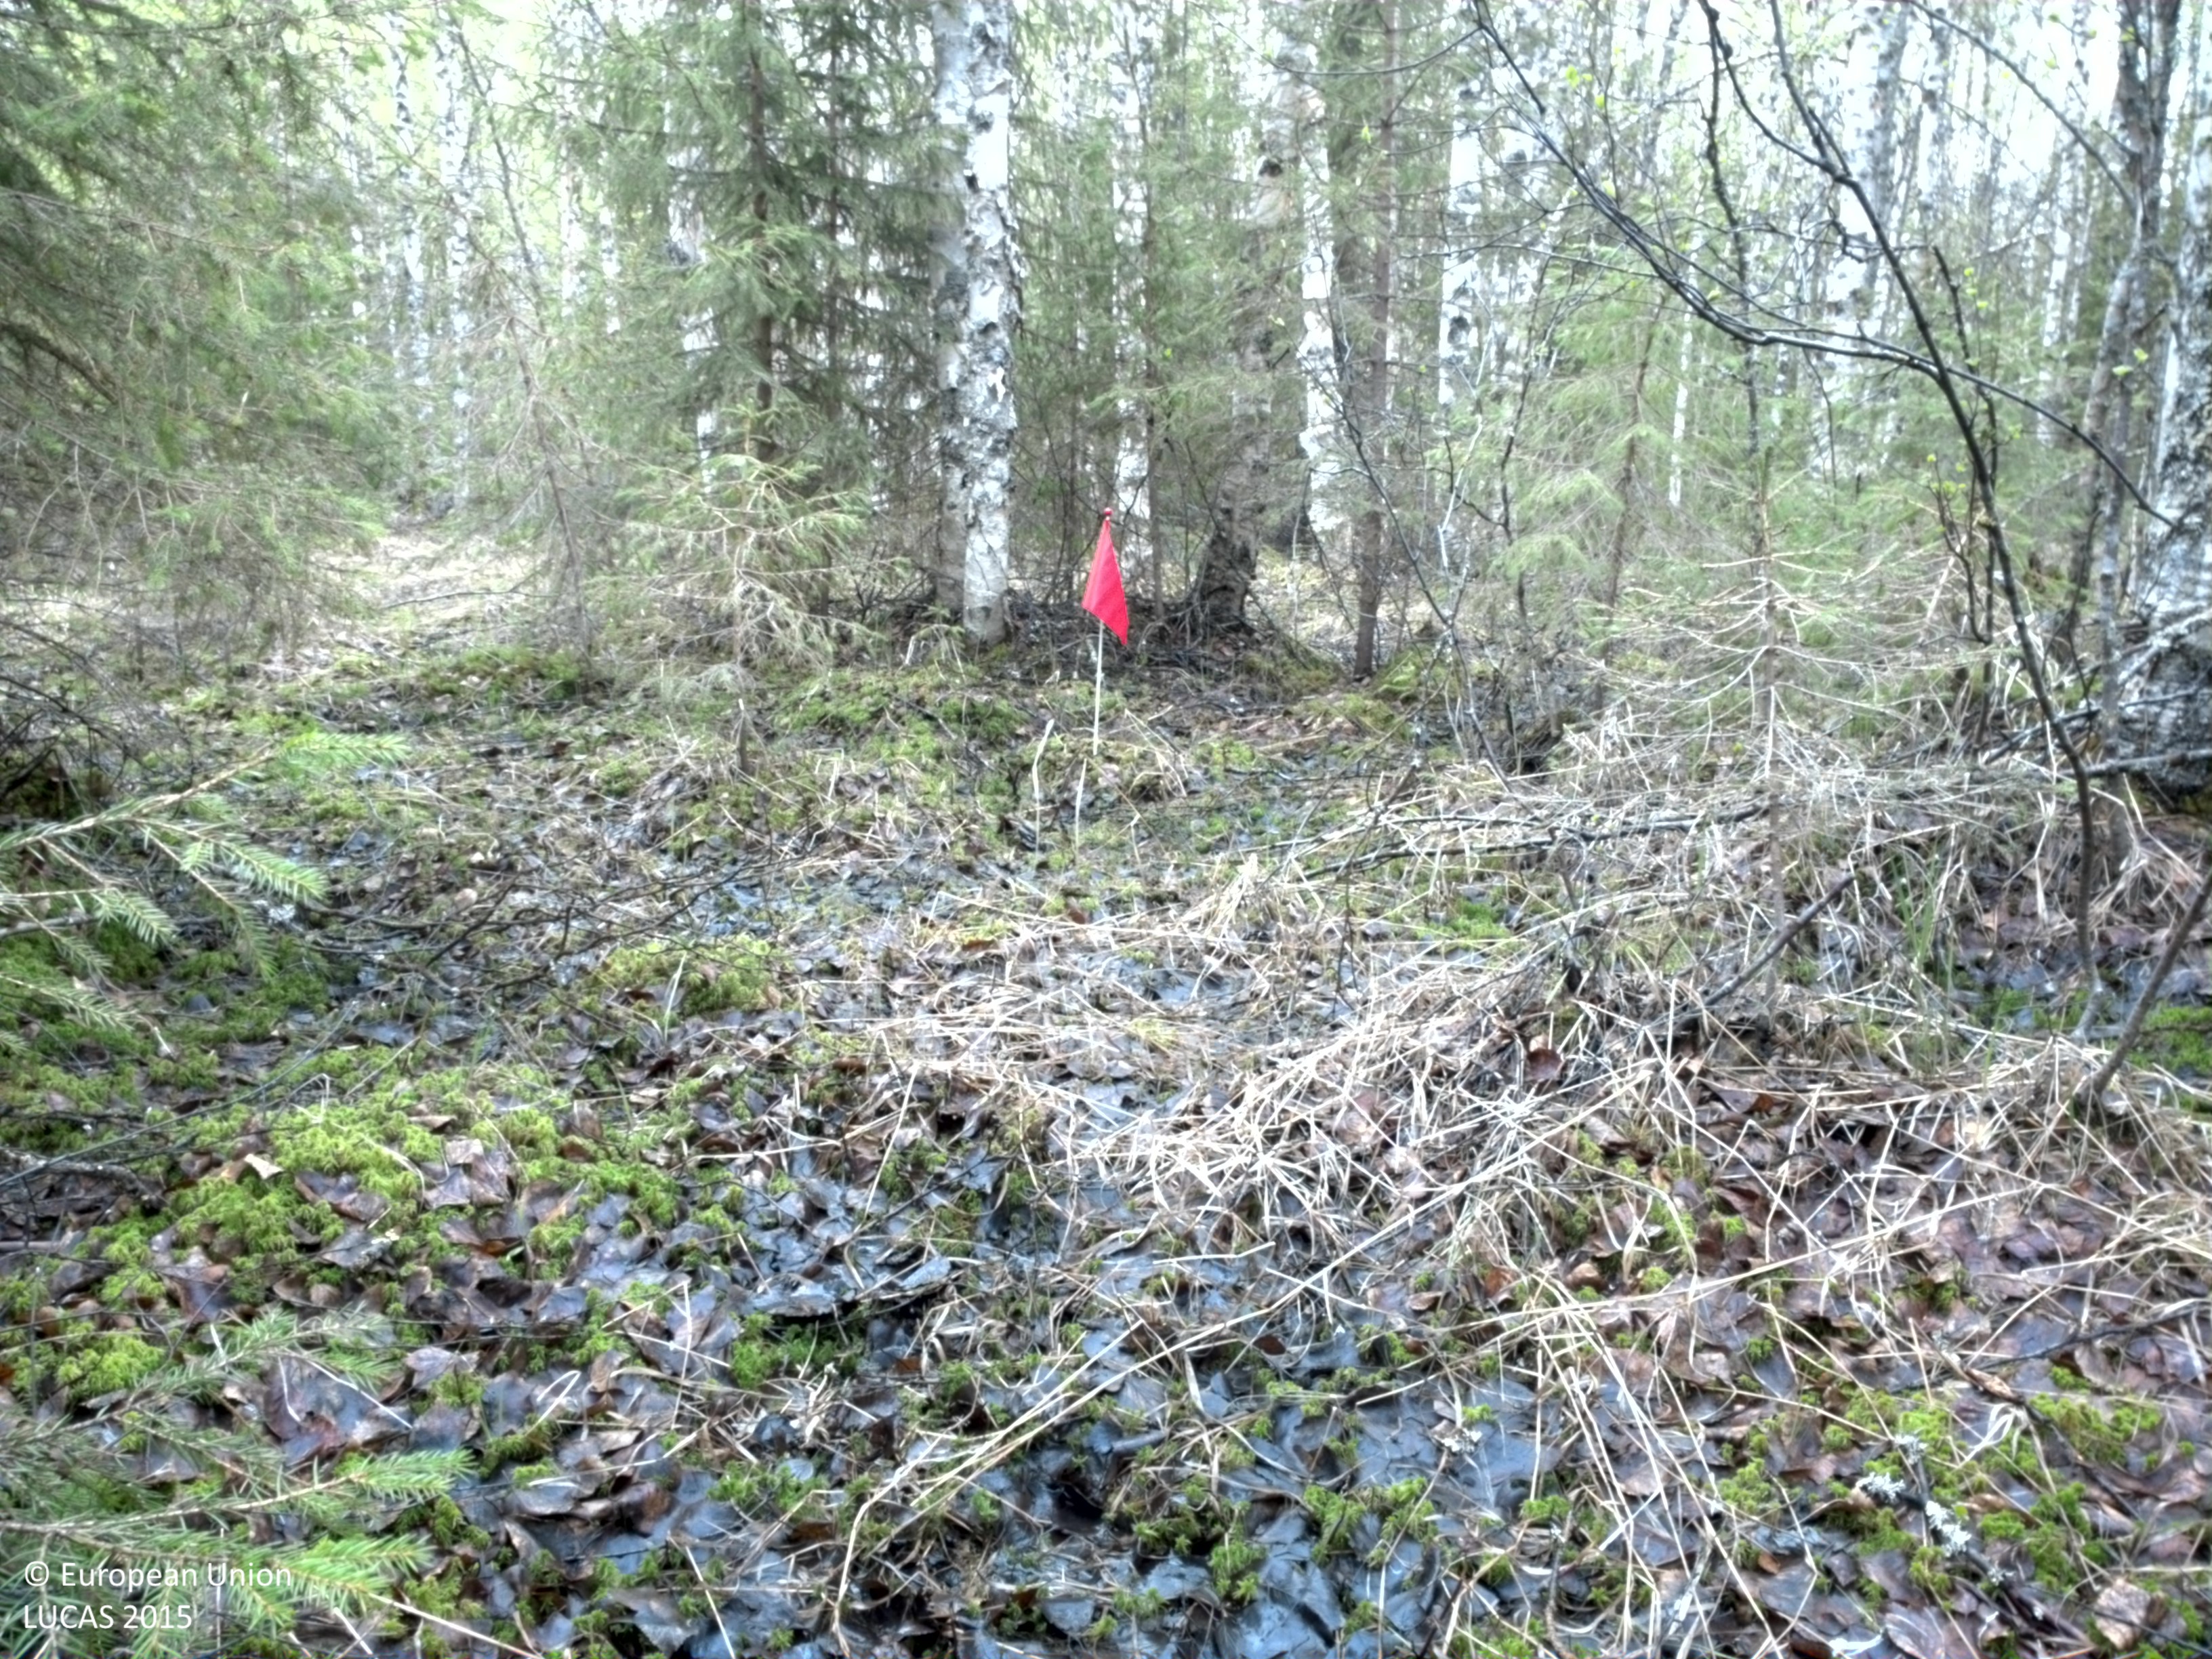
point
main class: Woodland
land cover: Broadleaved woodland
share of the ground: > 75 %
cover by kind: broadleaved forest trees 75 %, coniferous forest trees 10 %, lichens and mosses 10 %, herbaceous plants 5 %
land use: Forestry
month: June
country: SE
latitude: 65.9327
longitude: 23.2840
